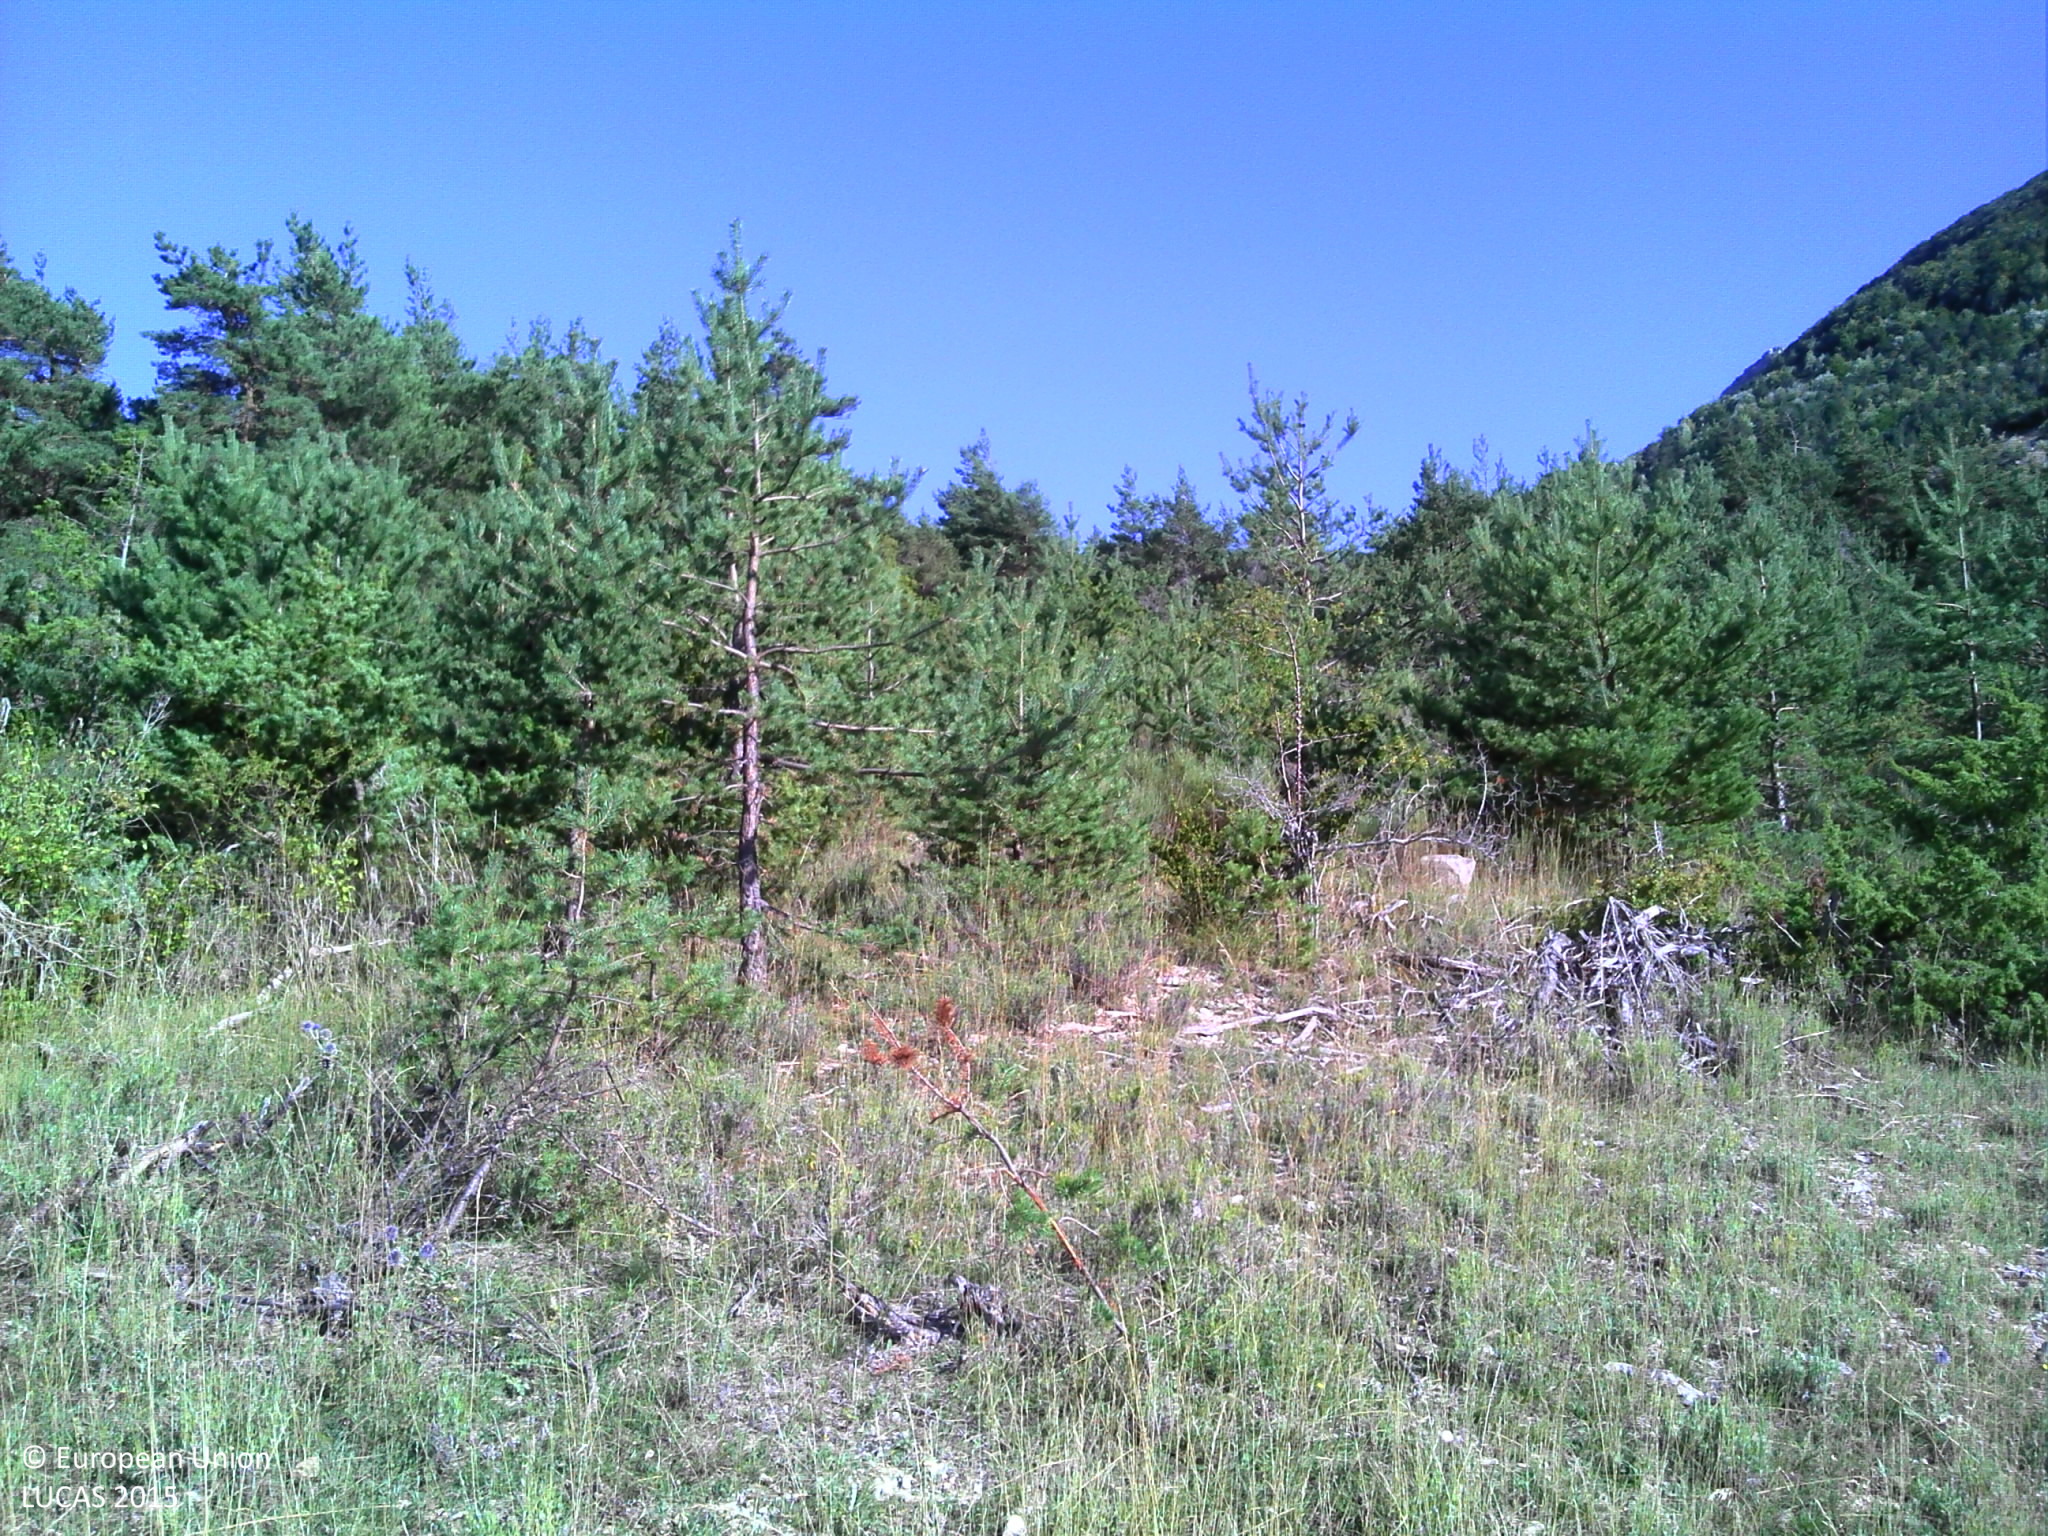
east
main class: Grassland
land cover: Grassland without tree/shrub cover
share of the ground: > 75 %
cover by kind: herbaceous plants 95 %, shrubs 5 %
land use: Agriculture (excluding fallow land and kitchen gardens)
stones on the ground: 25 - 50 %
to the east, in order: Grassland without tree/shrub cover; Tracks; Pine dominated coniferous woodland; Grassland without tree/shrub cover; Pine dominated coniferous woodland
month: September
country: FR
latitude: 44.4954
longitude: 5.2659
